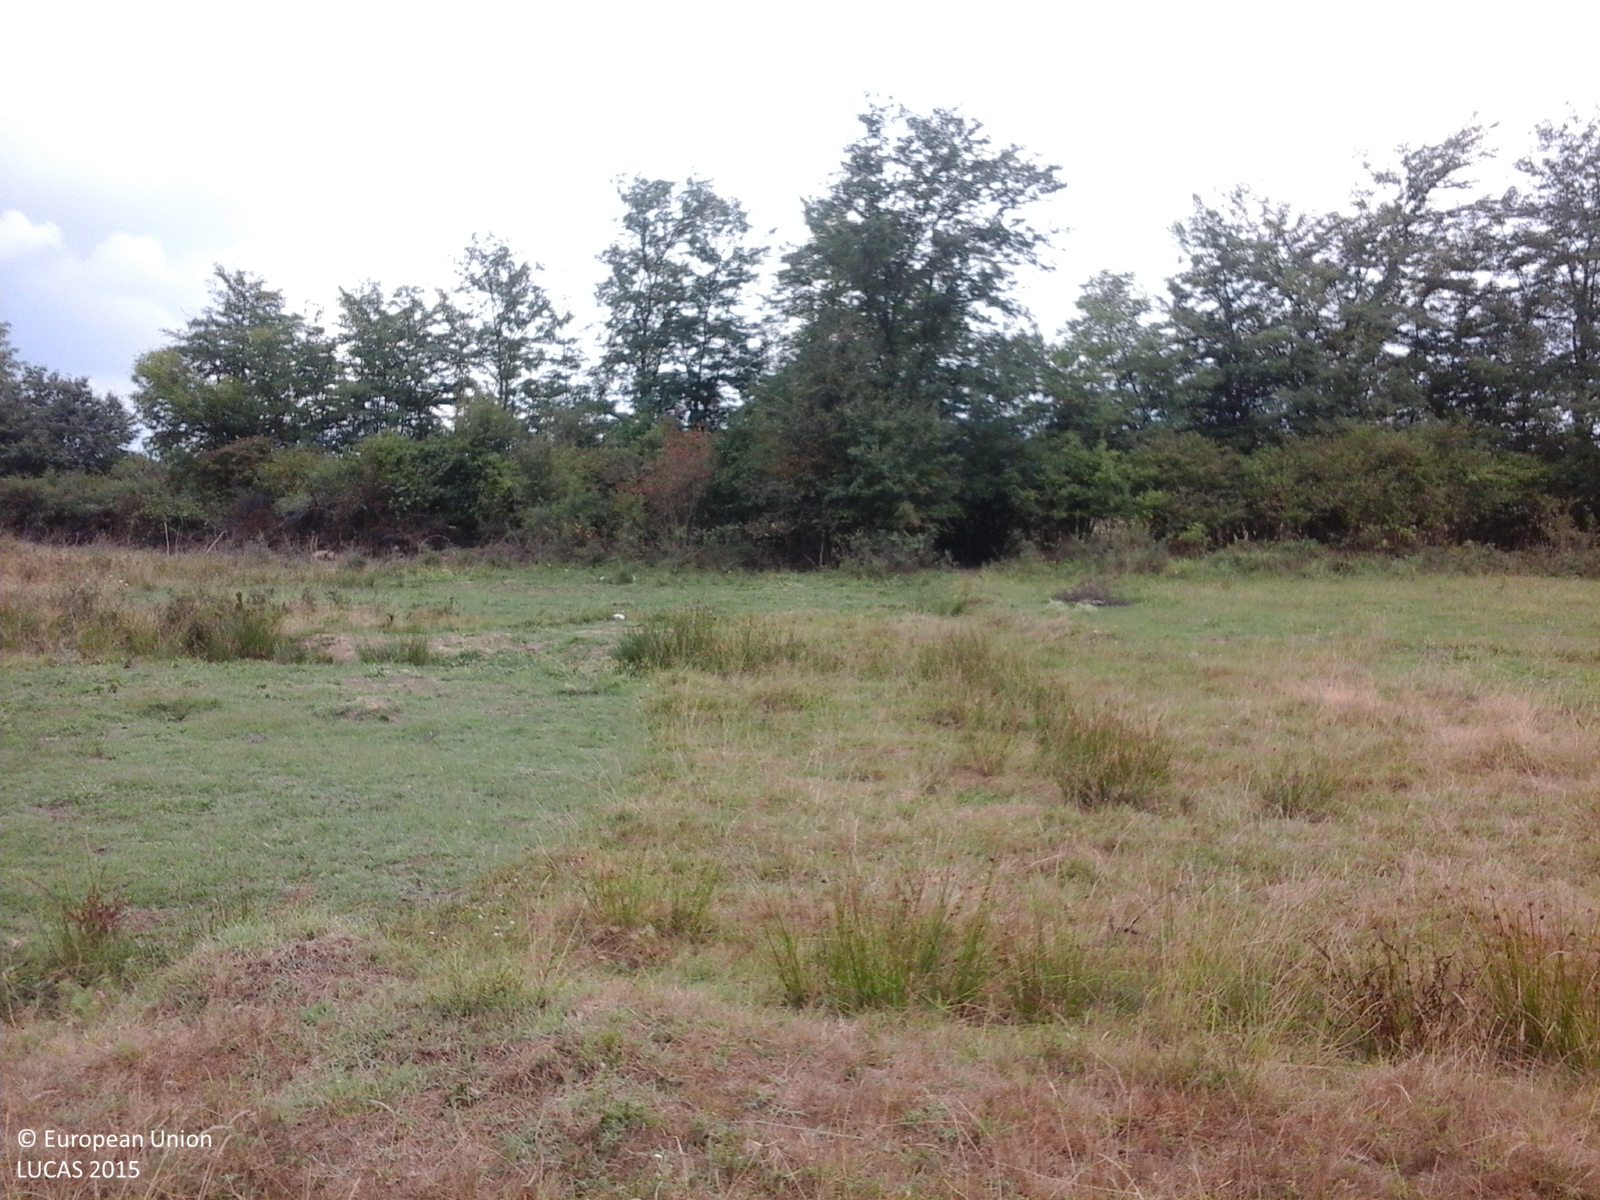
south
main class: Grassland
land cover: Grassland without tree/shrub cover
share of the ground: > 75 %
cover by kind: herbaceous plants 100 %
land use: Agriculture (excluding fallow land and kitchen gardens)
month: August
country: RO
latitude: 45.4865
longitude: 21.7163
